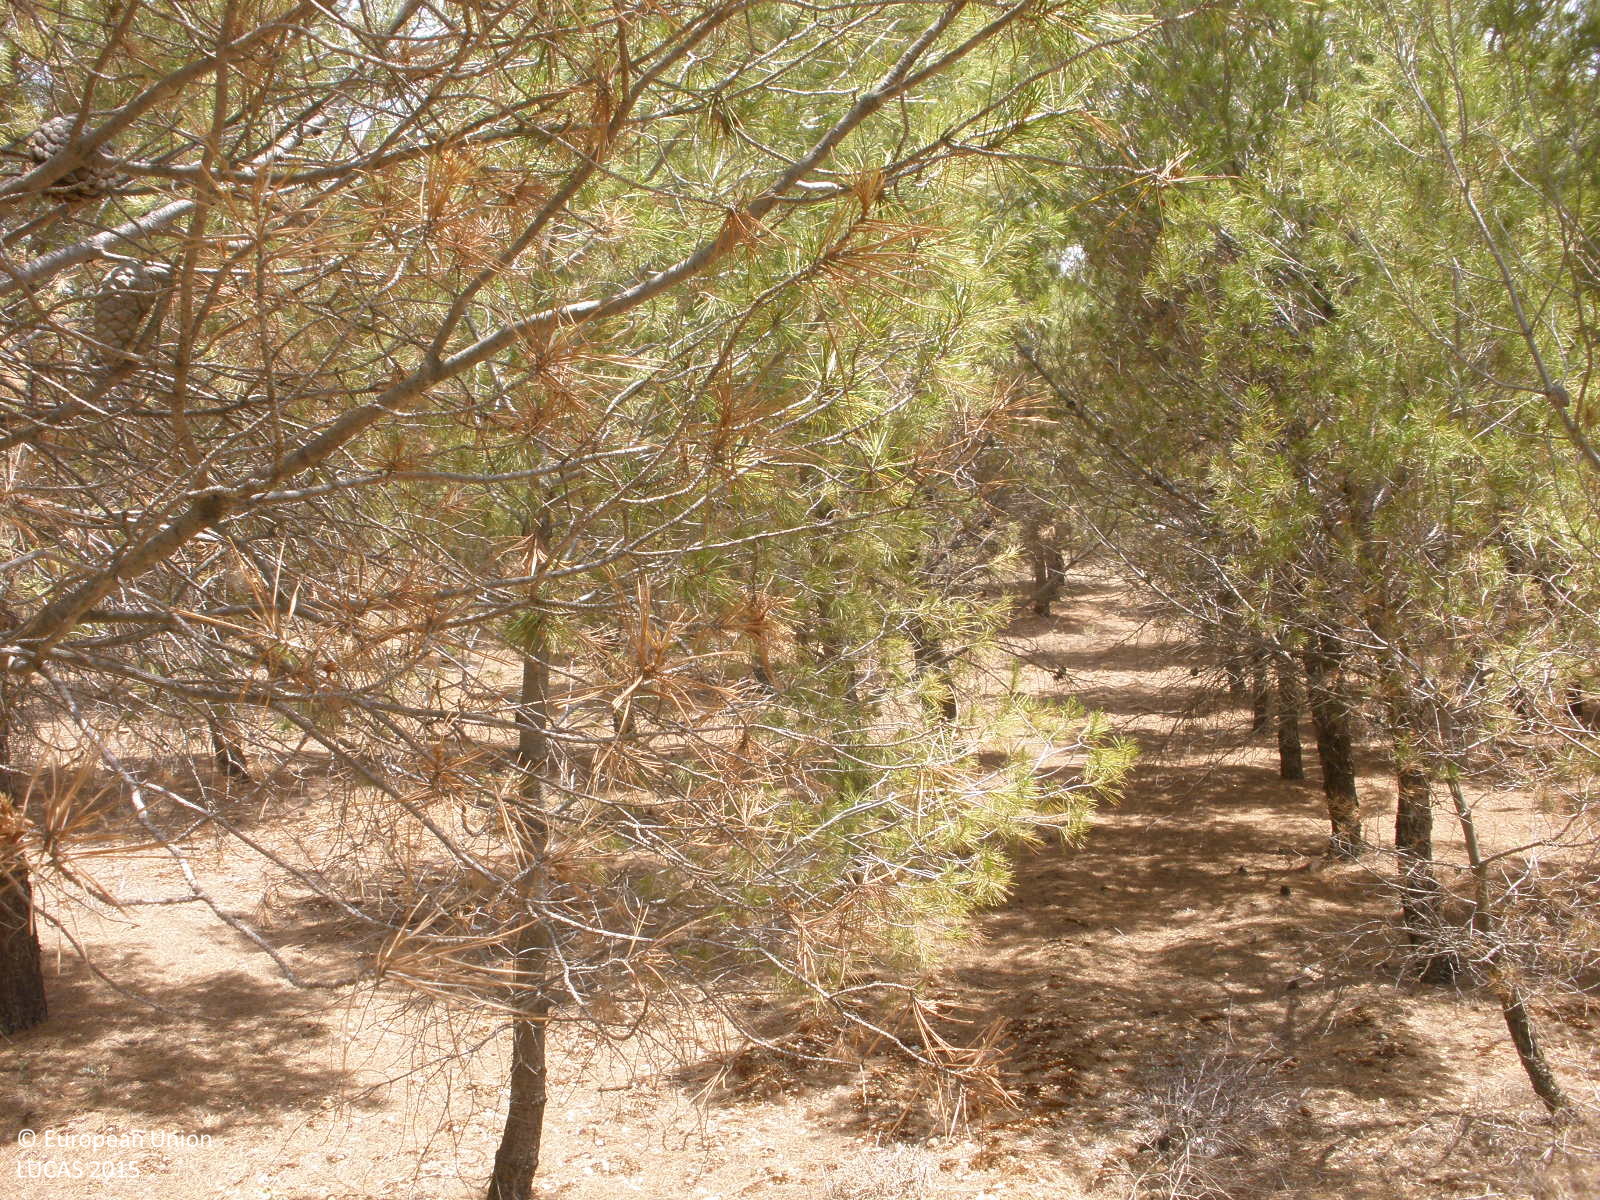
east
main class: Woodland
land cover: Pine dominated coniferous woodland
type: coniferous forest of the mediterranean region
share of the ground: 50 - 75 %
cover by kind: coniferous forest trees 70 %, herbaceous plants 20 %, consolidated bare surface 10 %
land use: Forestry
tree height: > 5 m
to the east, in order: Pine dominated coniferous woodland; Tracks; Pine dominated coniferous woodland; Rock outcrops; Pine dominated coniferous woodland; Tracks; Pine dominated coniferous woodland
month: July
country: ES
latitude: 39.8194
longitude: -3.4024
